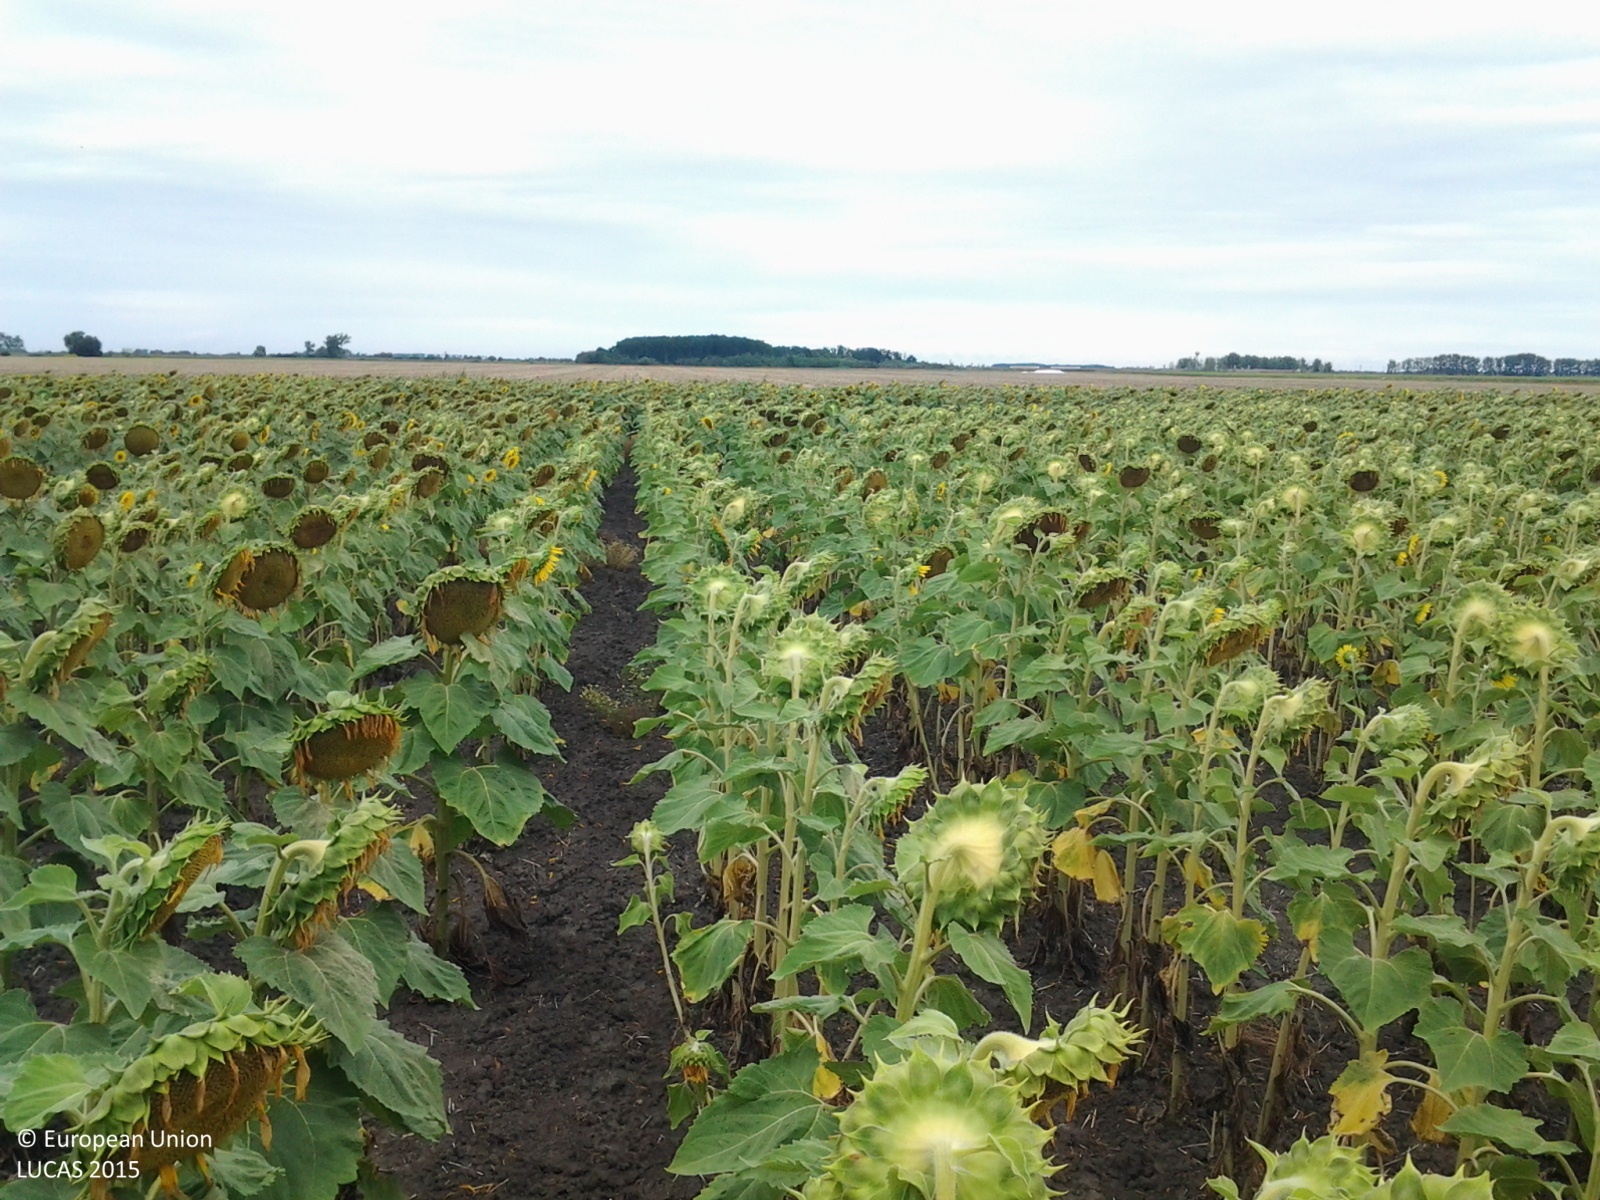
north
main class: Cropland
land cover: Sunflower
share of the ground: > 75 %
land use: Agriculture (excluding fallow land and kitchen gardens)
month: July
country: HU
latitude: 47.1363
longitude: 20.5380
